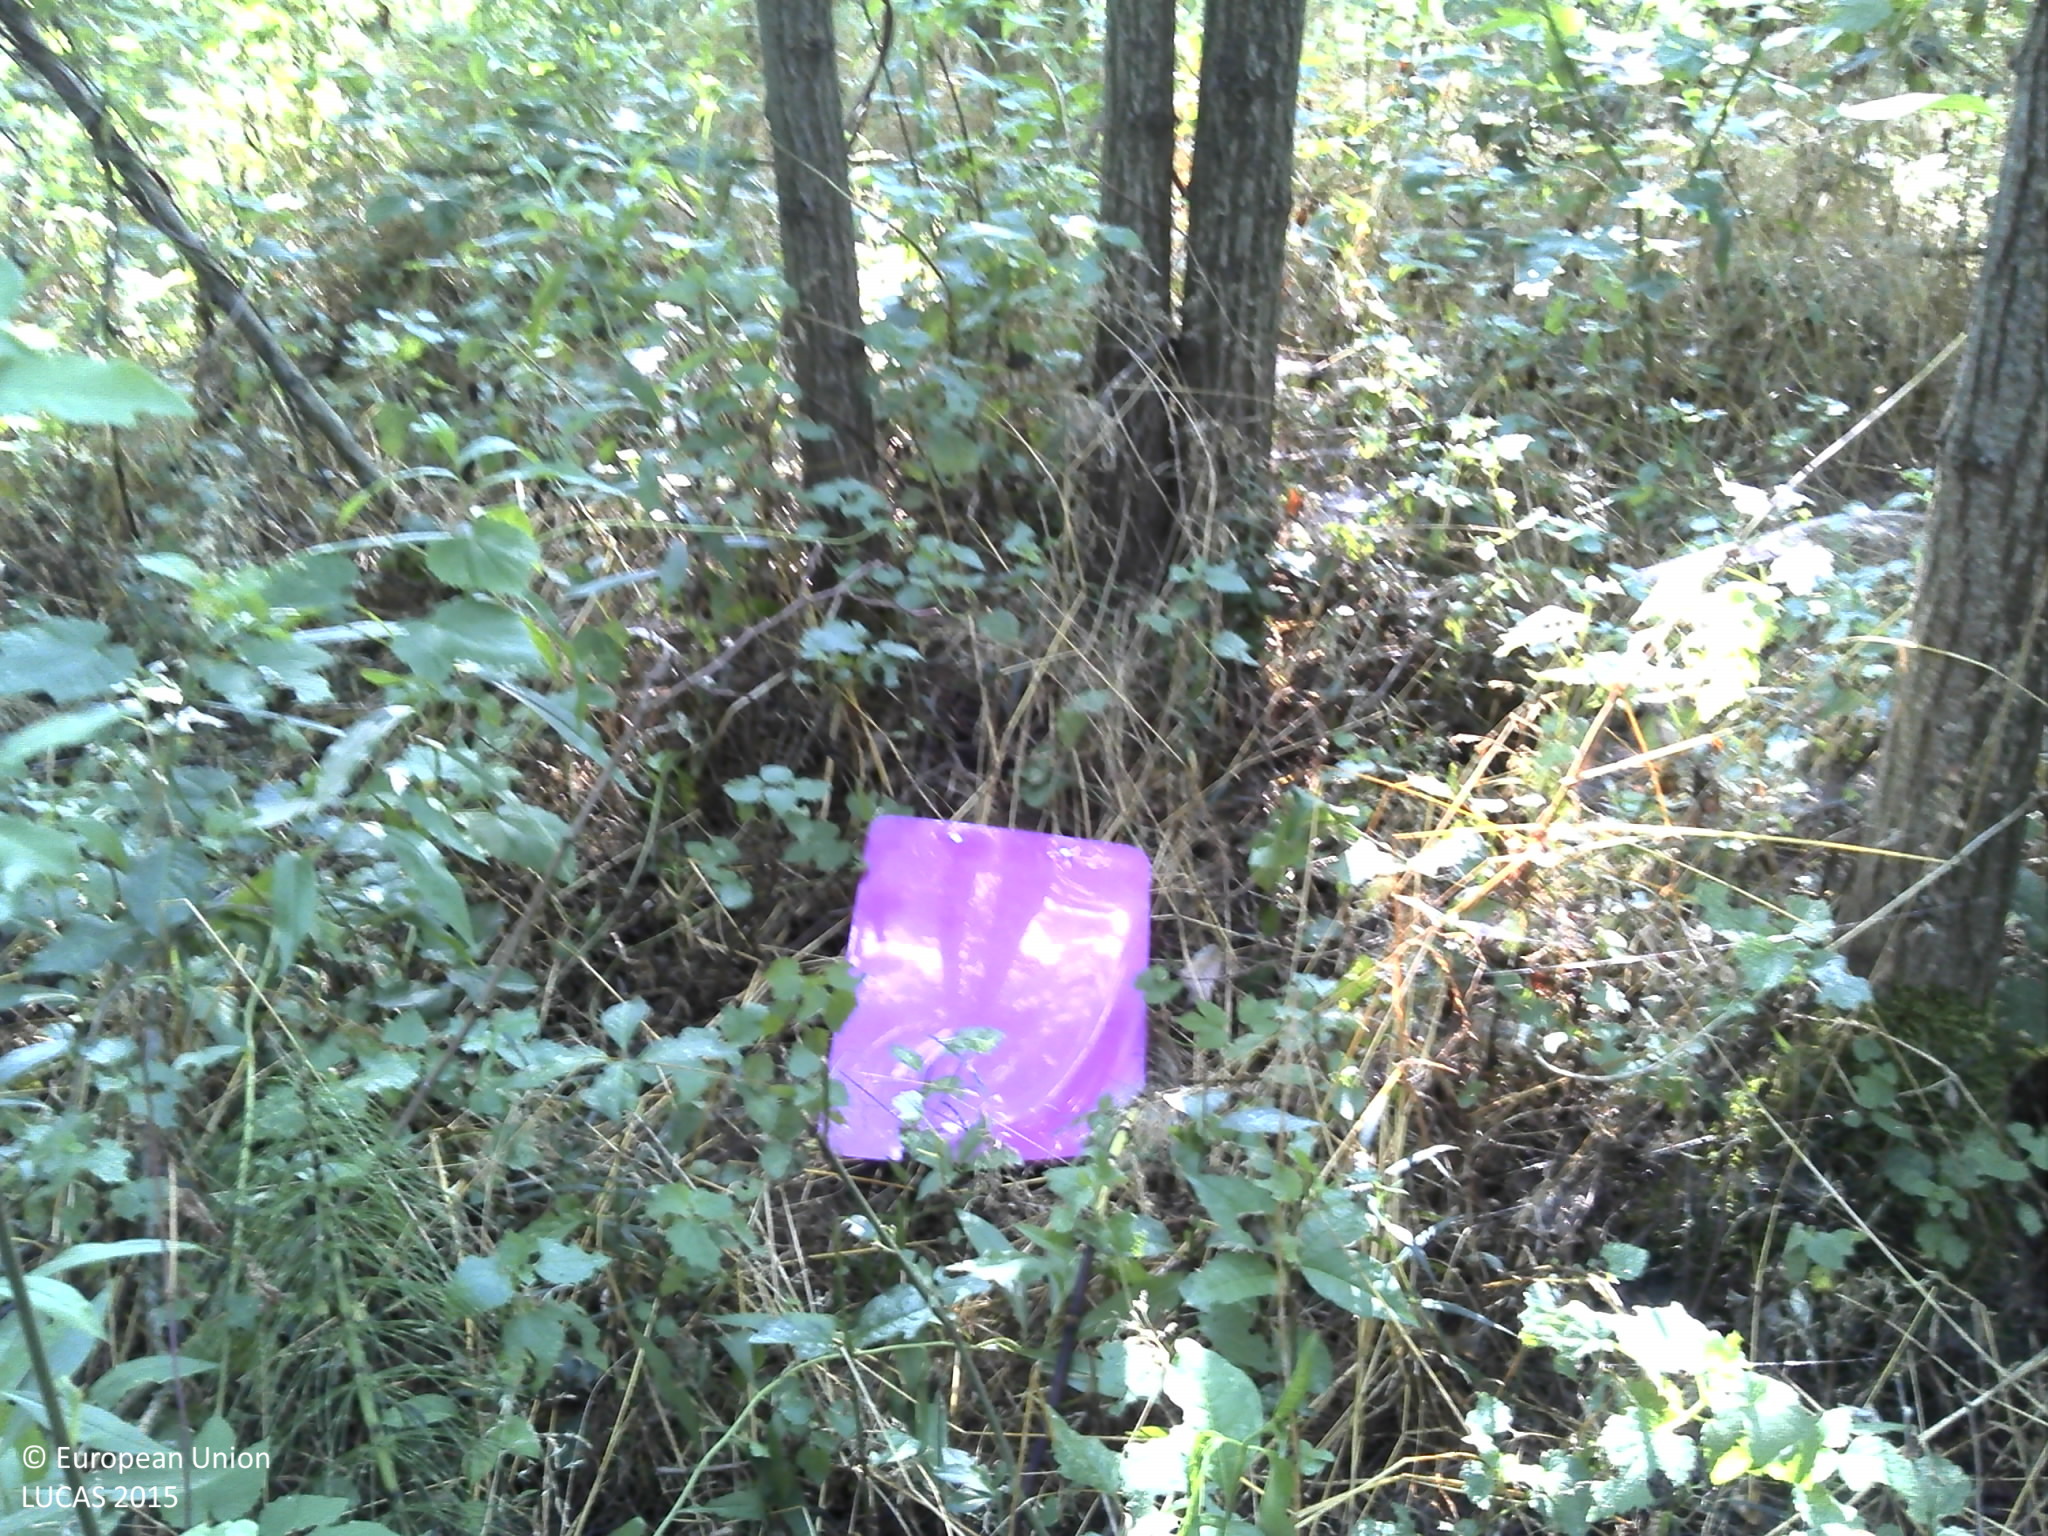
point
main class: Shrubland
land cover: Shrubland with sparse tree cover
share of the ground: > 75 %
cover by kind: shrubs 95 %, broadleaved forest trees 5 %
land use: Semi-natural and natural areas not in use
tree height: < 5 m
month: July
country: HR
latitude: 45.5073
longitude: 16.7184
